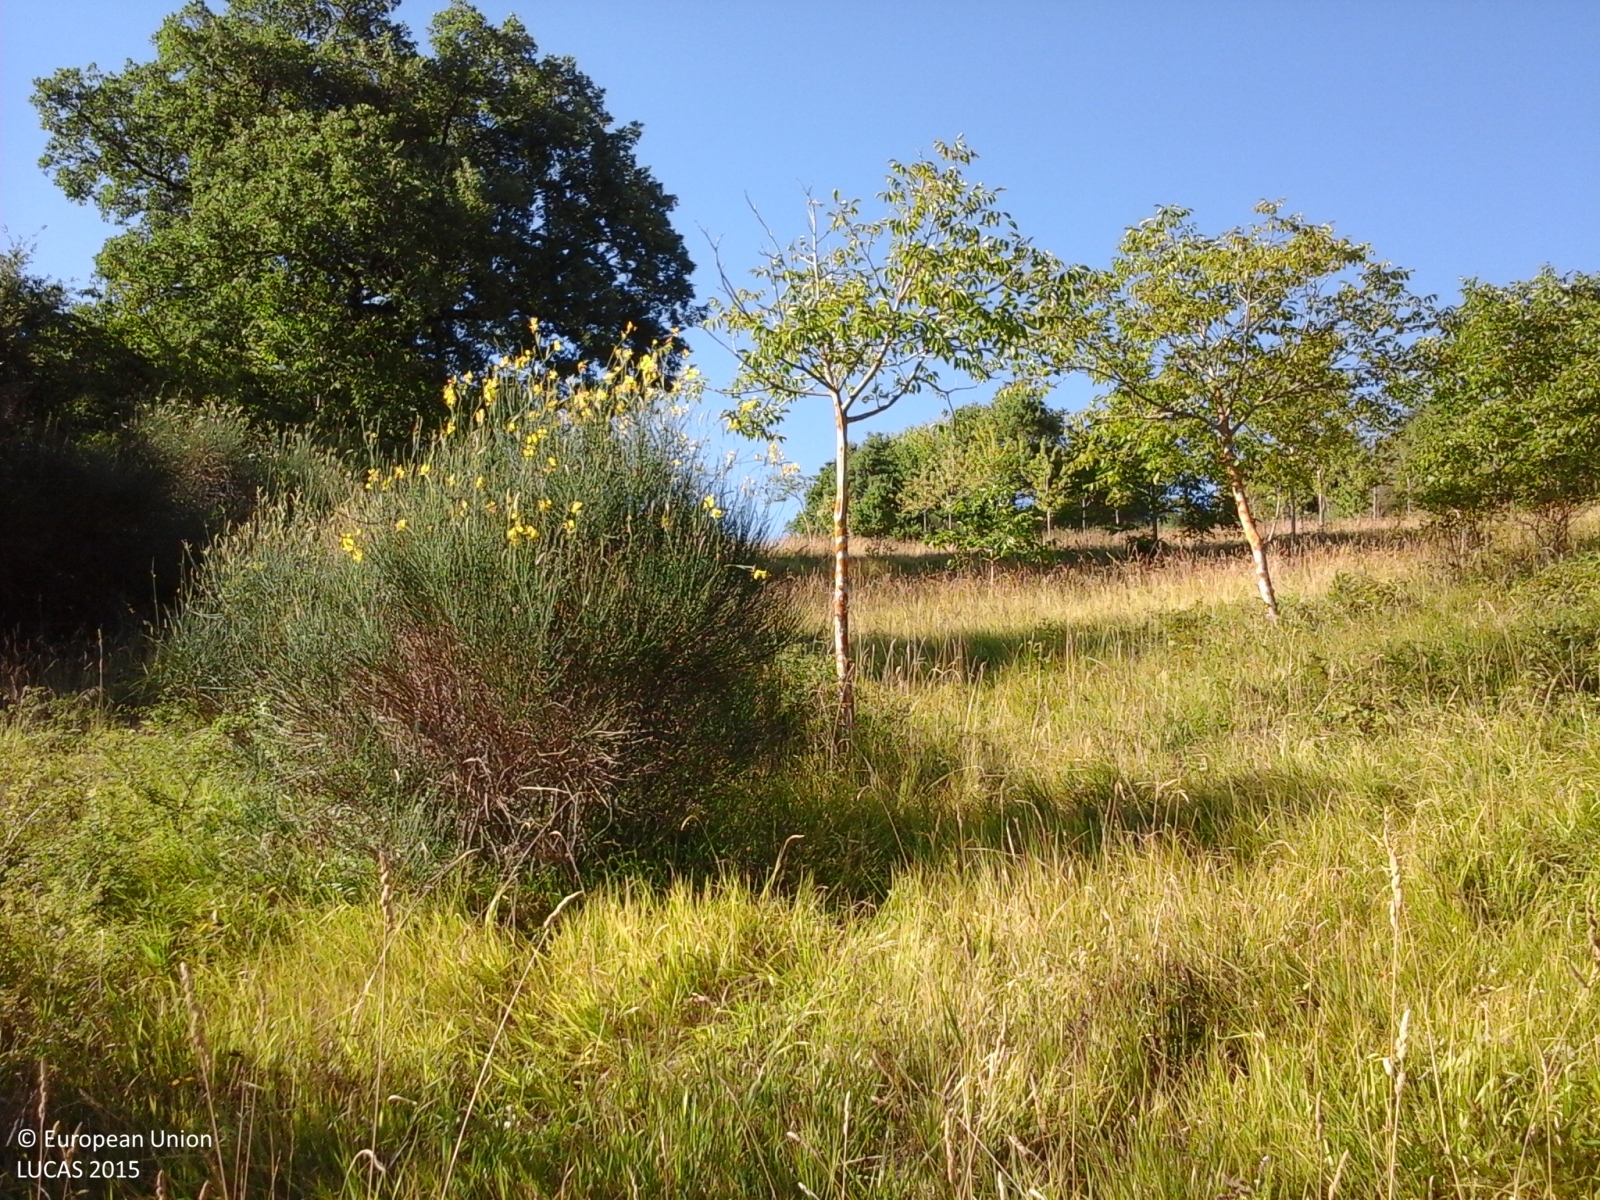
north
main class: Cropland
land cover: Nuts trees
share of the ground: 25 - 50 %
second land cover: Grassland without tree/shrub cover
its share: > 75 %
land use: Agriculture (excluding fallow land and kitchen gardens)
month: August
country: IT
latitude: 43.5279
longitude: 12.4312
